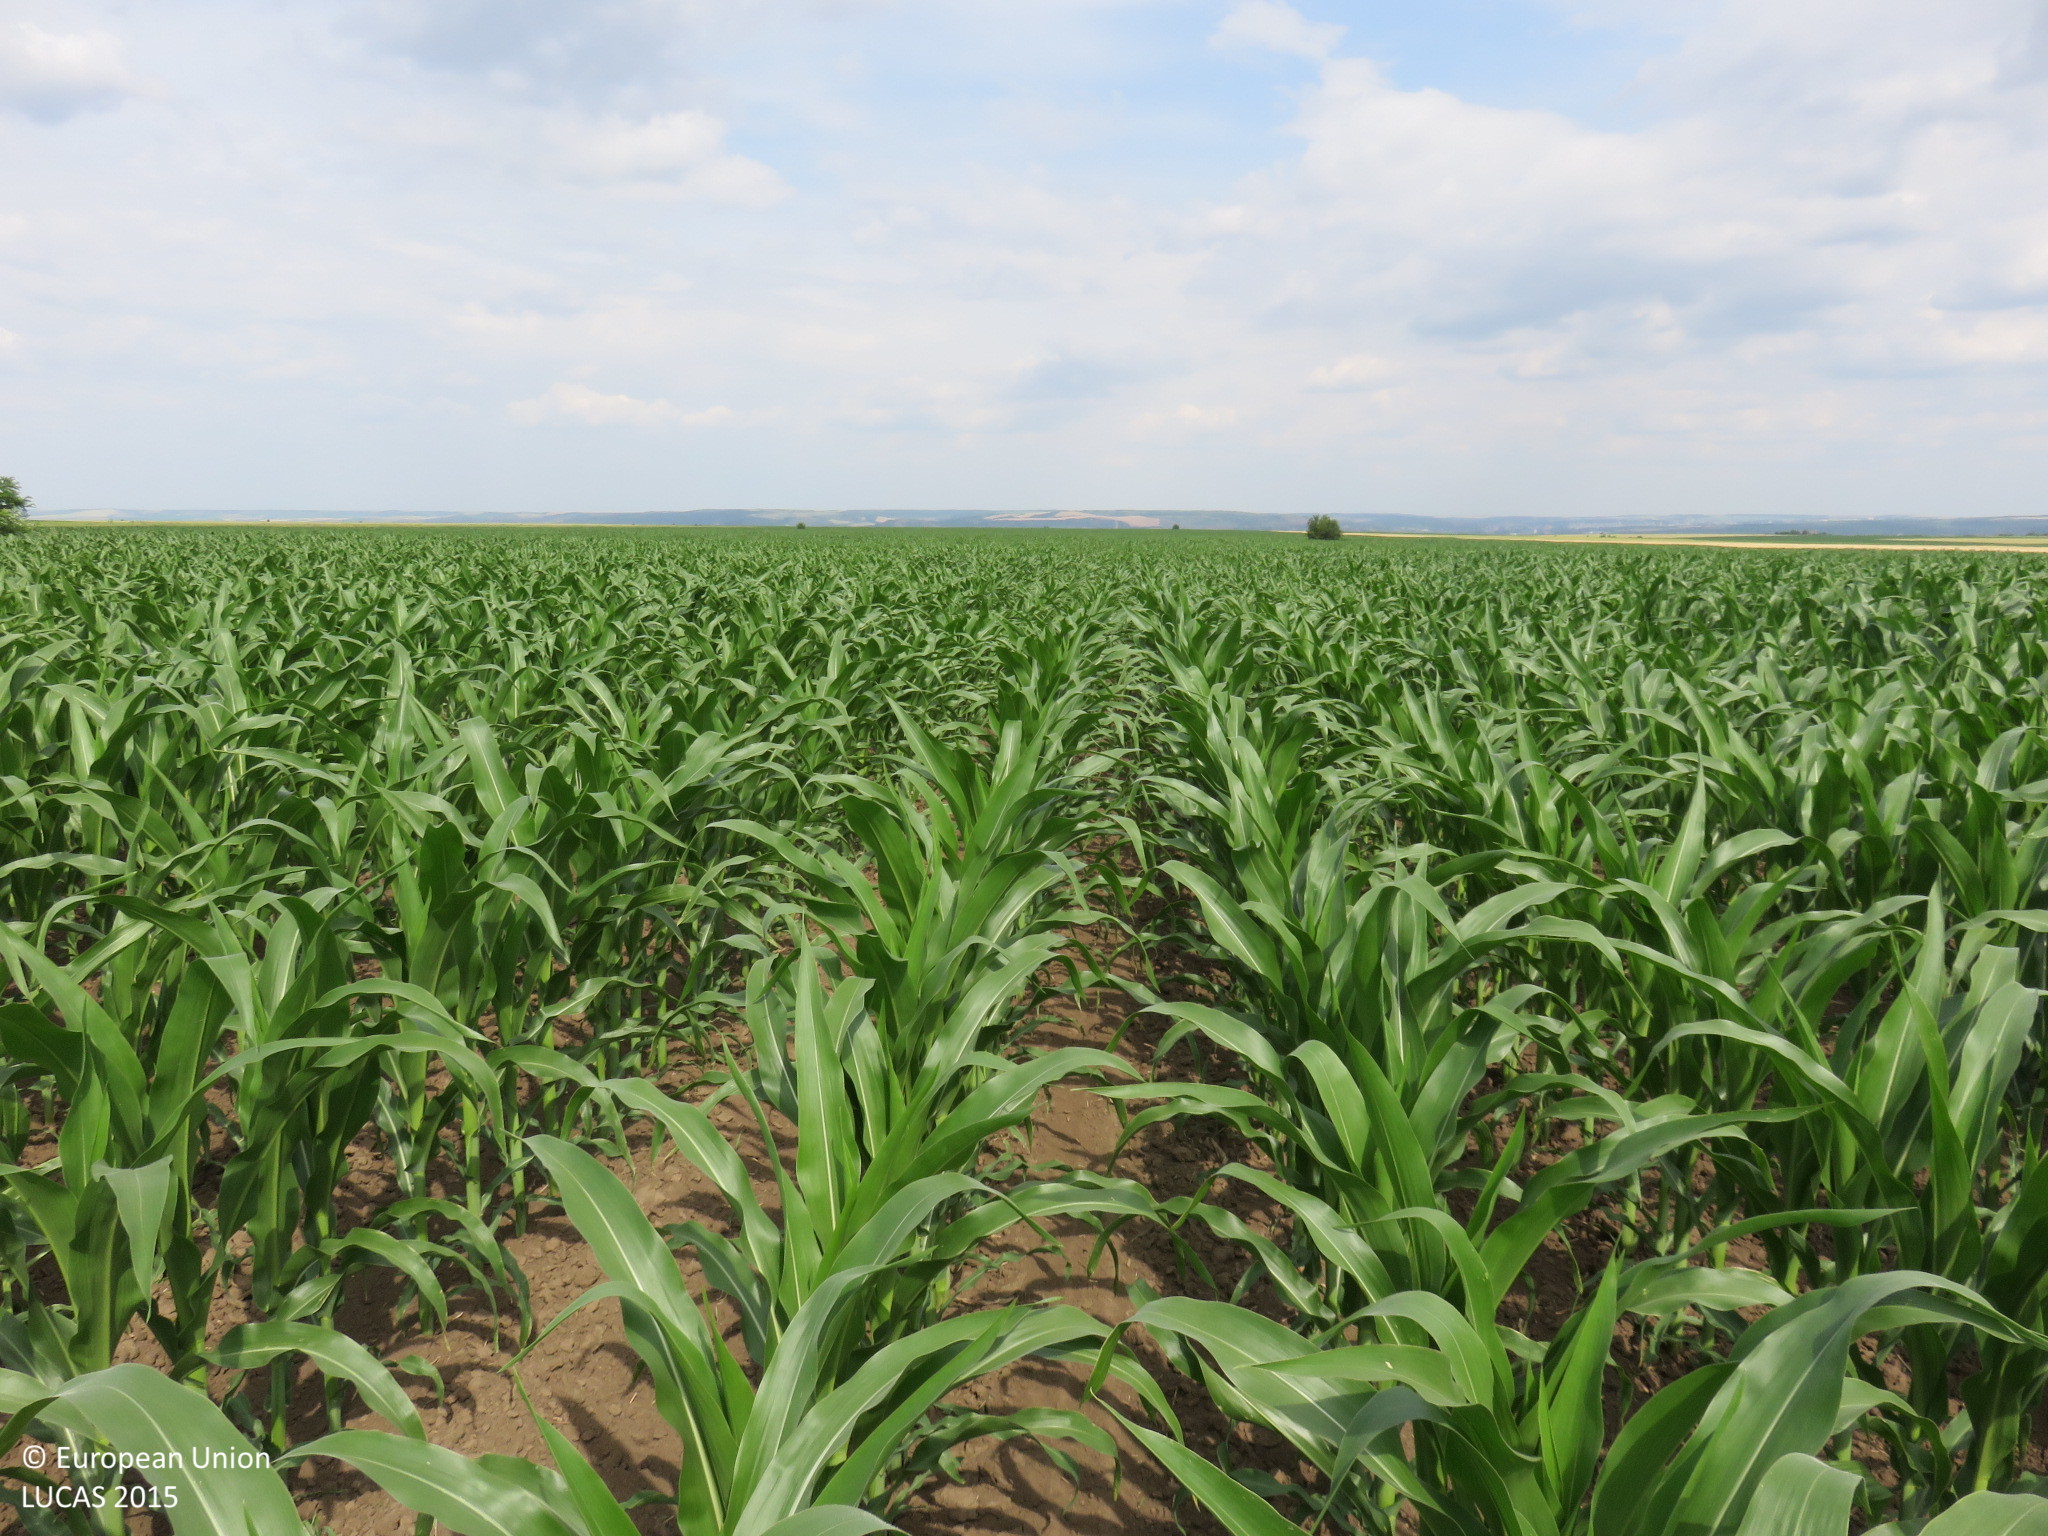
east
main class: Cropland
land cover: Maize
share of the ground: > 75 %
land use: Agriculture (excluding fallow land and kitchen gardens)
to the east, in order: Maize
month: June
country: BG
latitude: 43.4809
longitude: 24.4392
